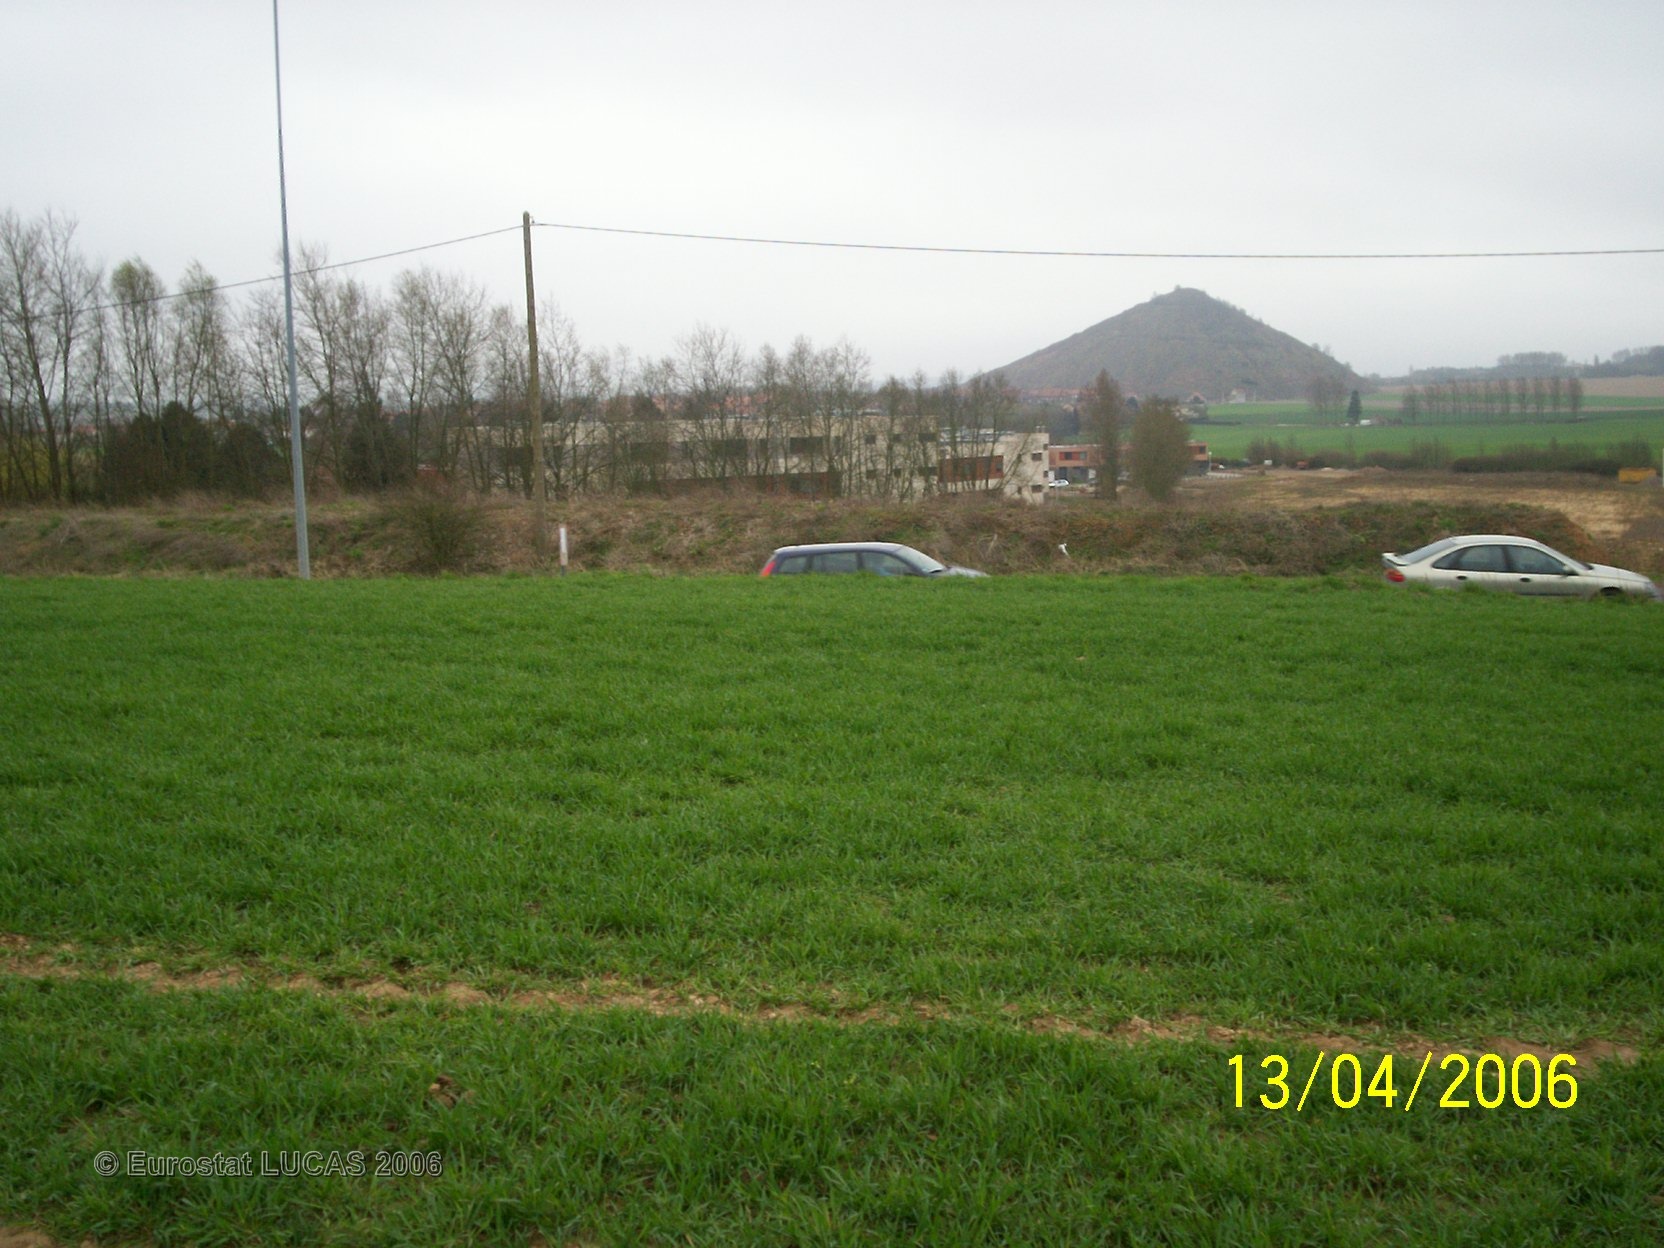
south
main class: Cropland
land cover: Common wheat
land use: Agriculture (excluding fallow land and kitchen gardens)
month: April
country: FR
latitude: 50.4988
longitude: 2.5297
